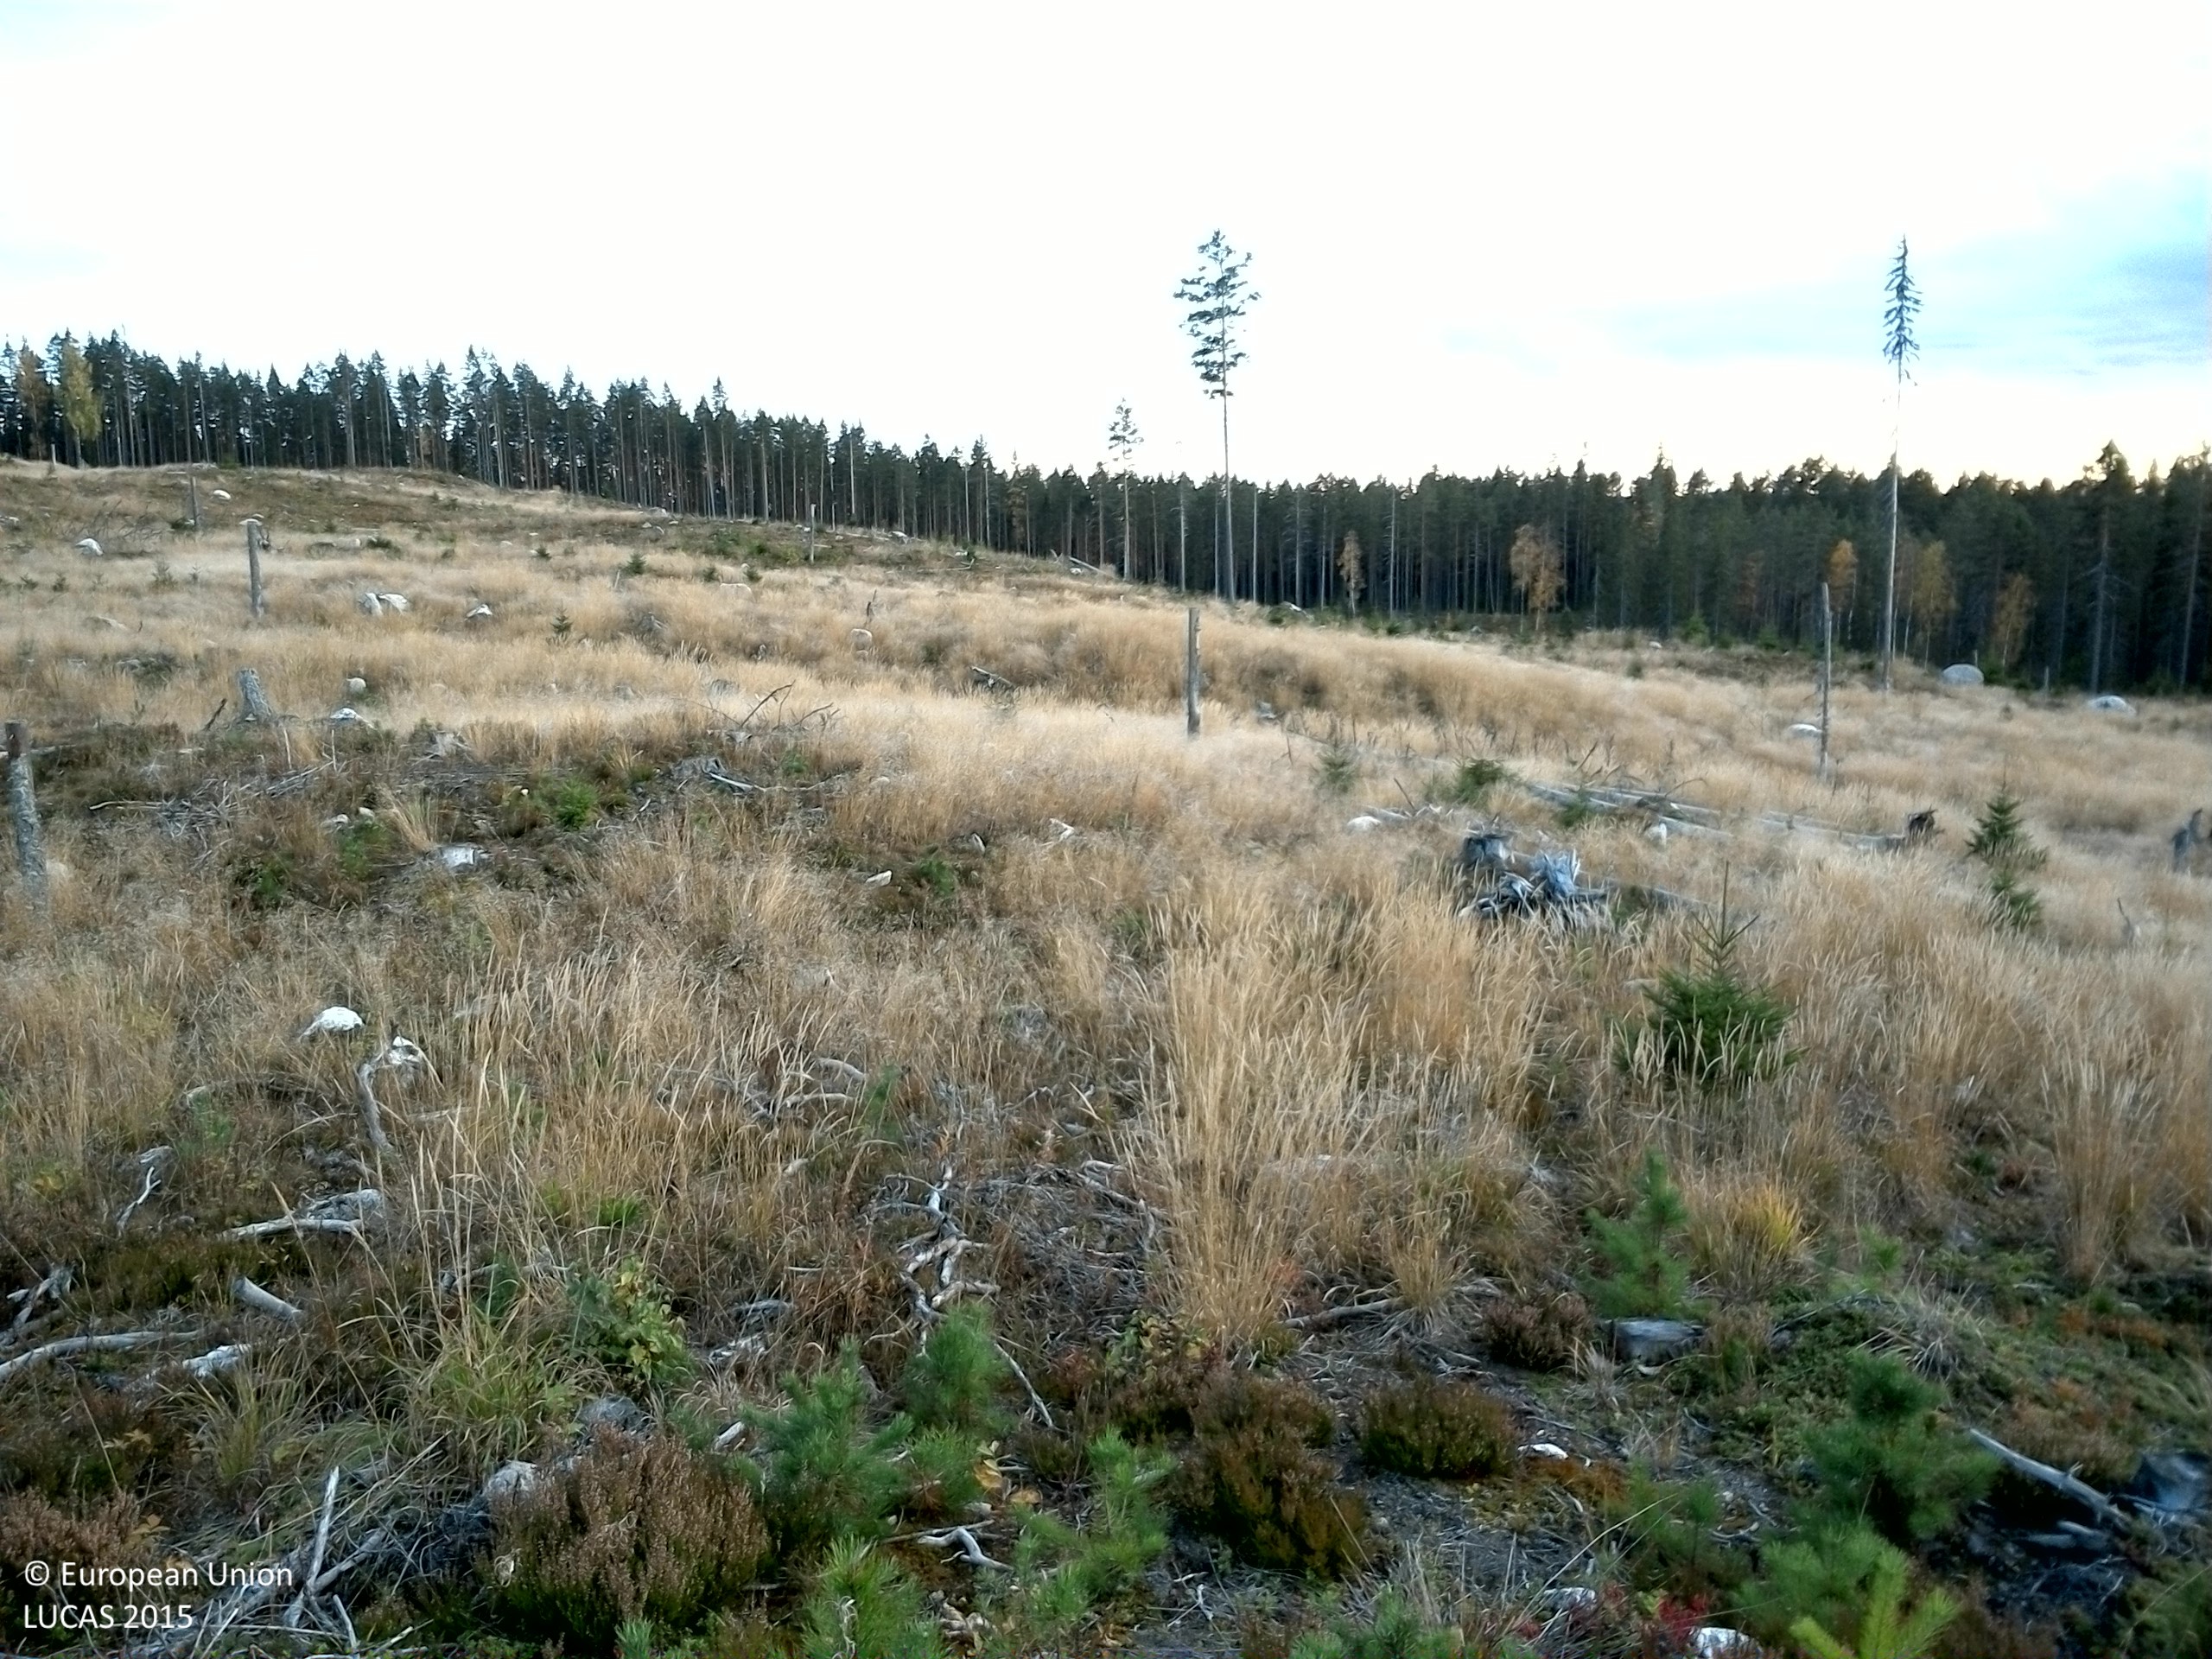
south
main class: Shrubland
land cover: Shrubland with sparse tree cover
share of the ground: > 75 %
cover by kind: shrubs 50 %, herbaceous plants 15 %, lichens and mosses 15 %, consolidated bare surface 15 %, coniferous forest trees 5 %
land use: Forestry
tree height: < 5 m
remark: Clear cut
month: October
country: SE
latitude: 61.4074
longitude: 15.0608
